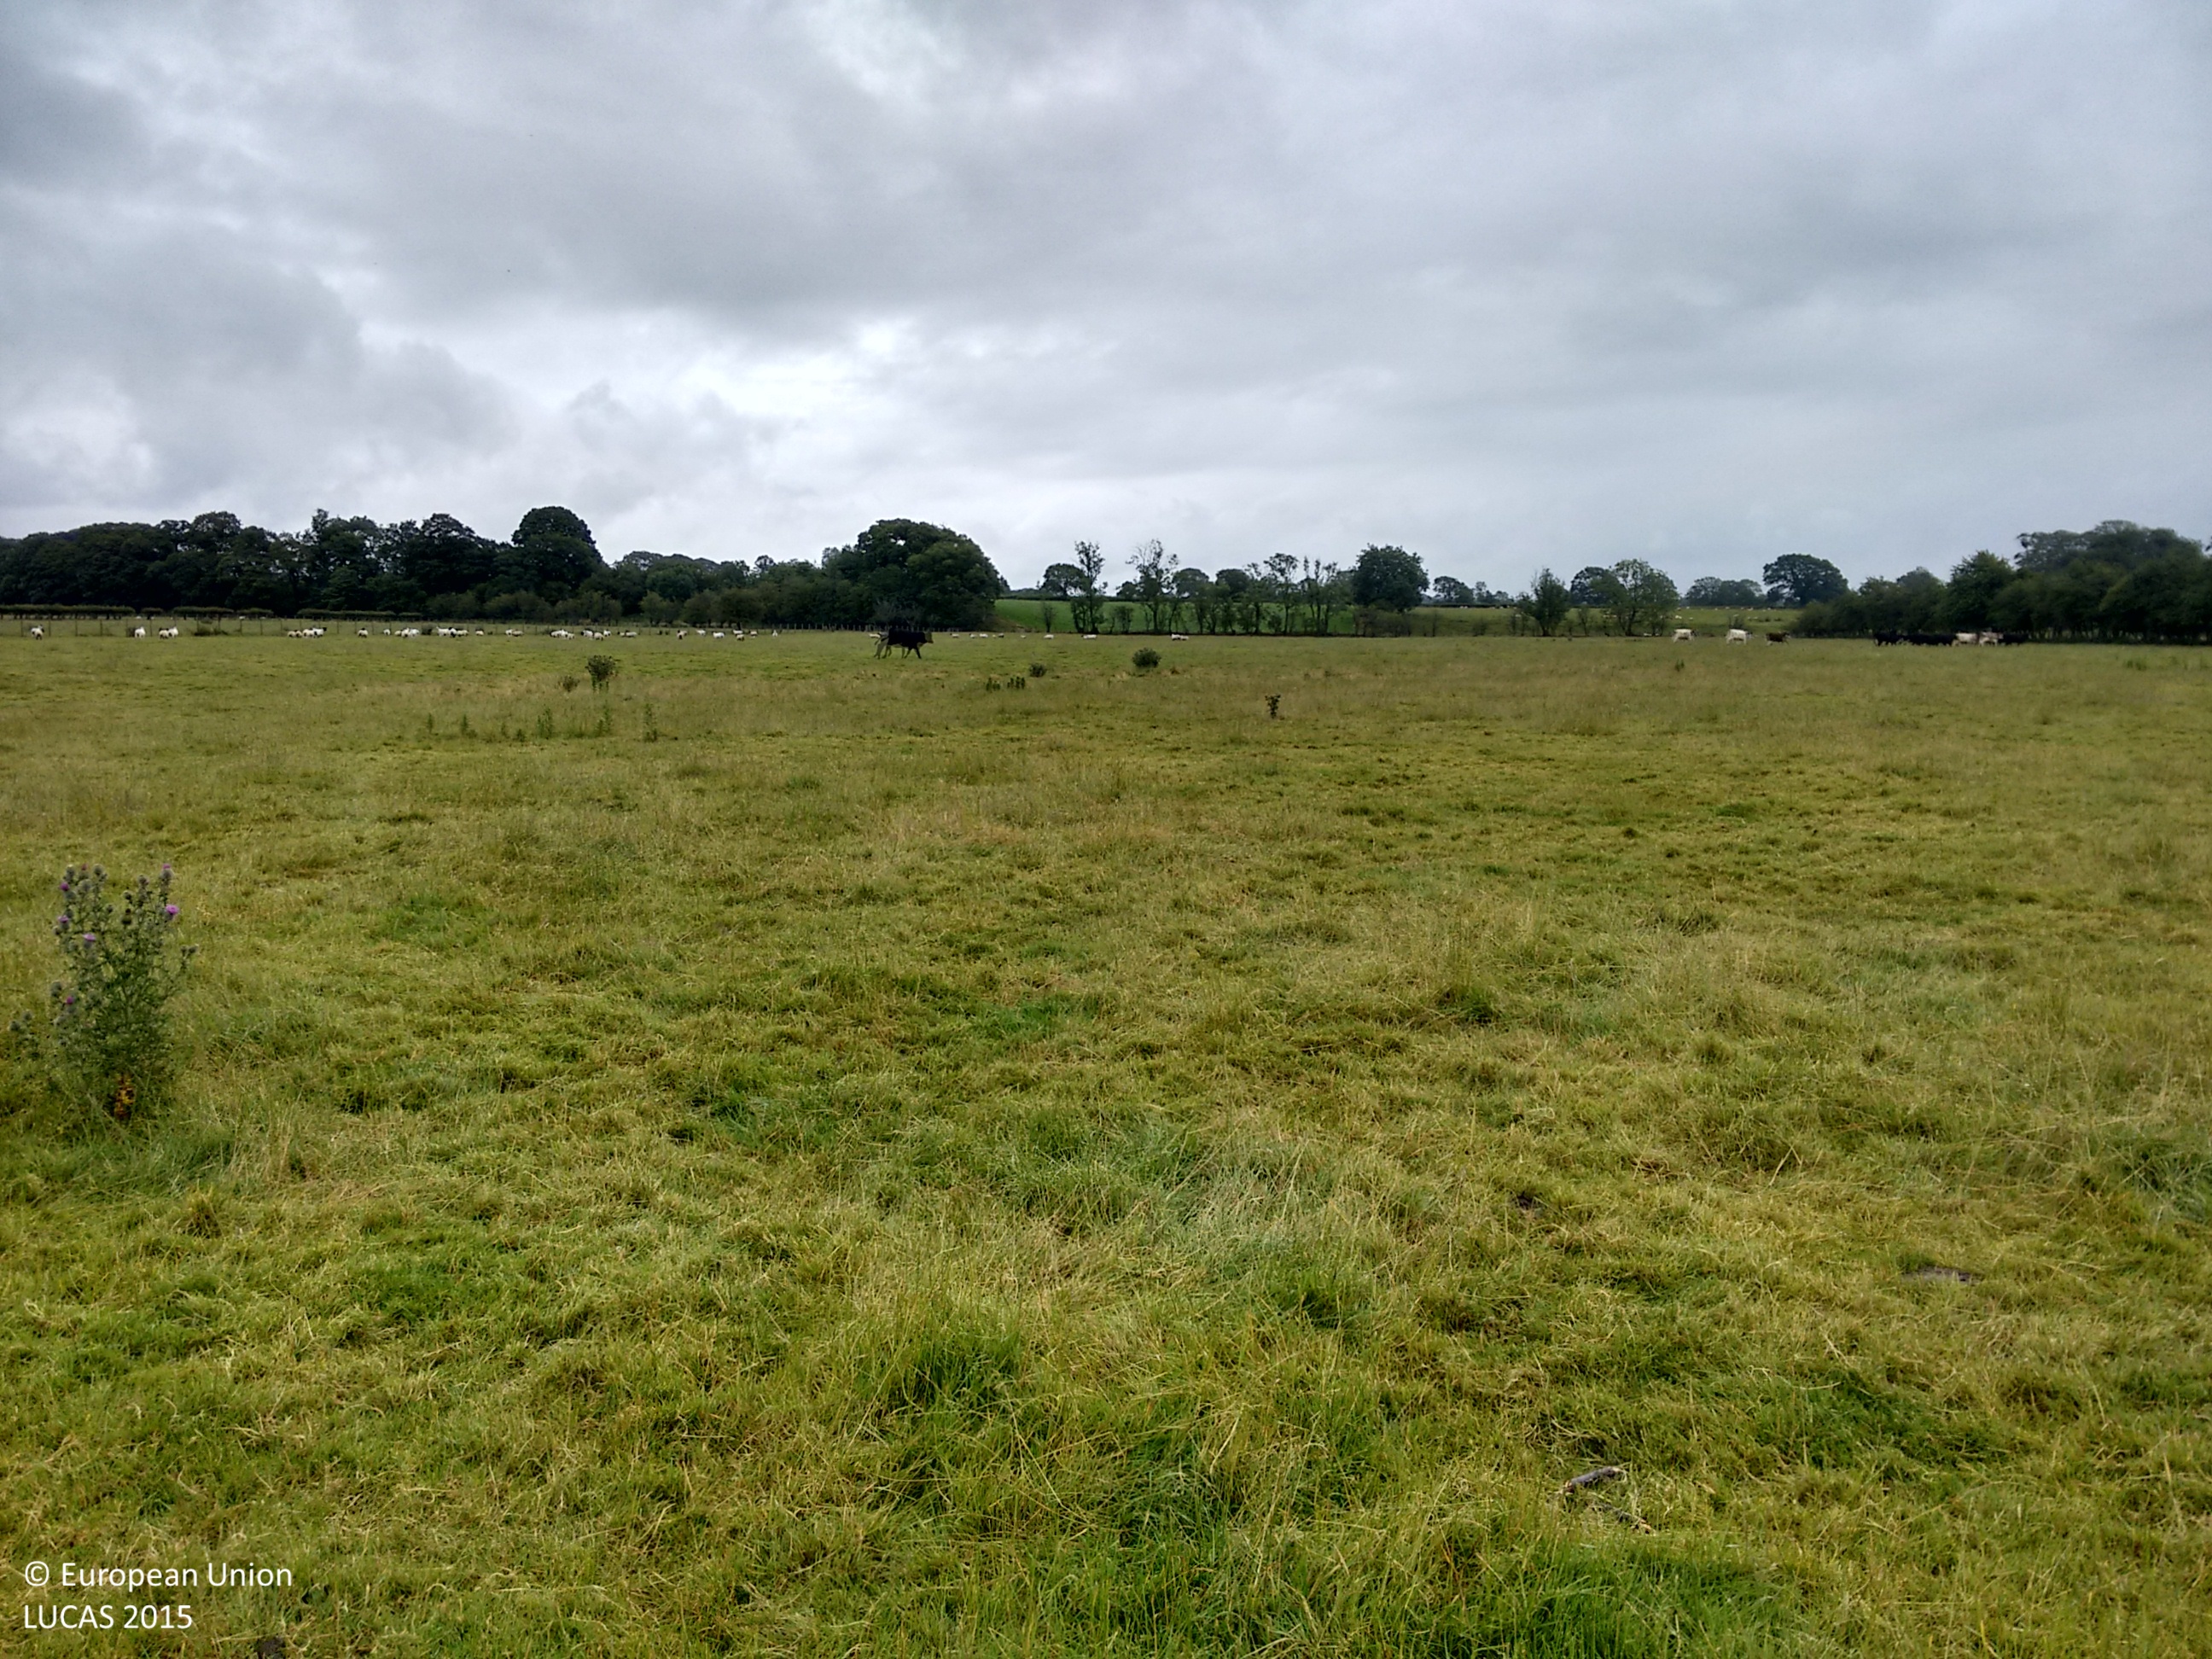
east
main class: Grassland
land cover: Grassland without tree/shrub cover
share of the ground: > 75 %
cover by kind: herbaceous plants 100 %
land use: Agriculture (excluding fallow land and kitchen gardens)
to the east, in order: Grassland without tree/shrub cover; Single bushes/trees; Fences; Grassland without tree/shrub cover
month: July
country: GB
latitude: 54.9830
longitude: -2.9305
